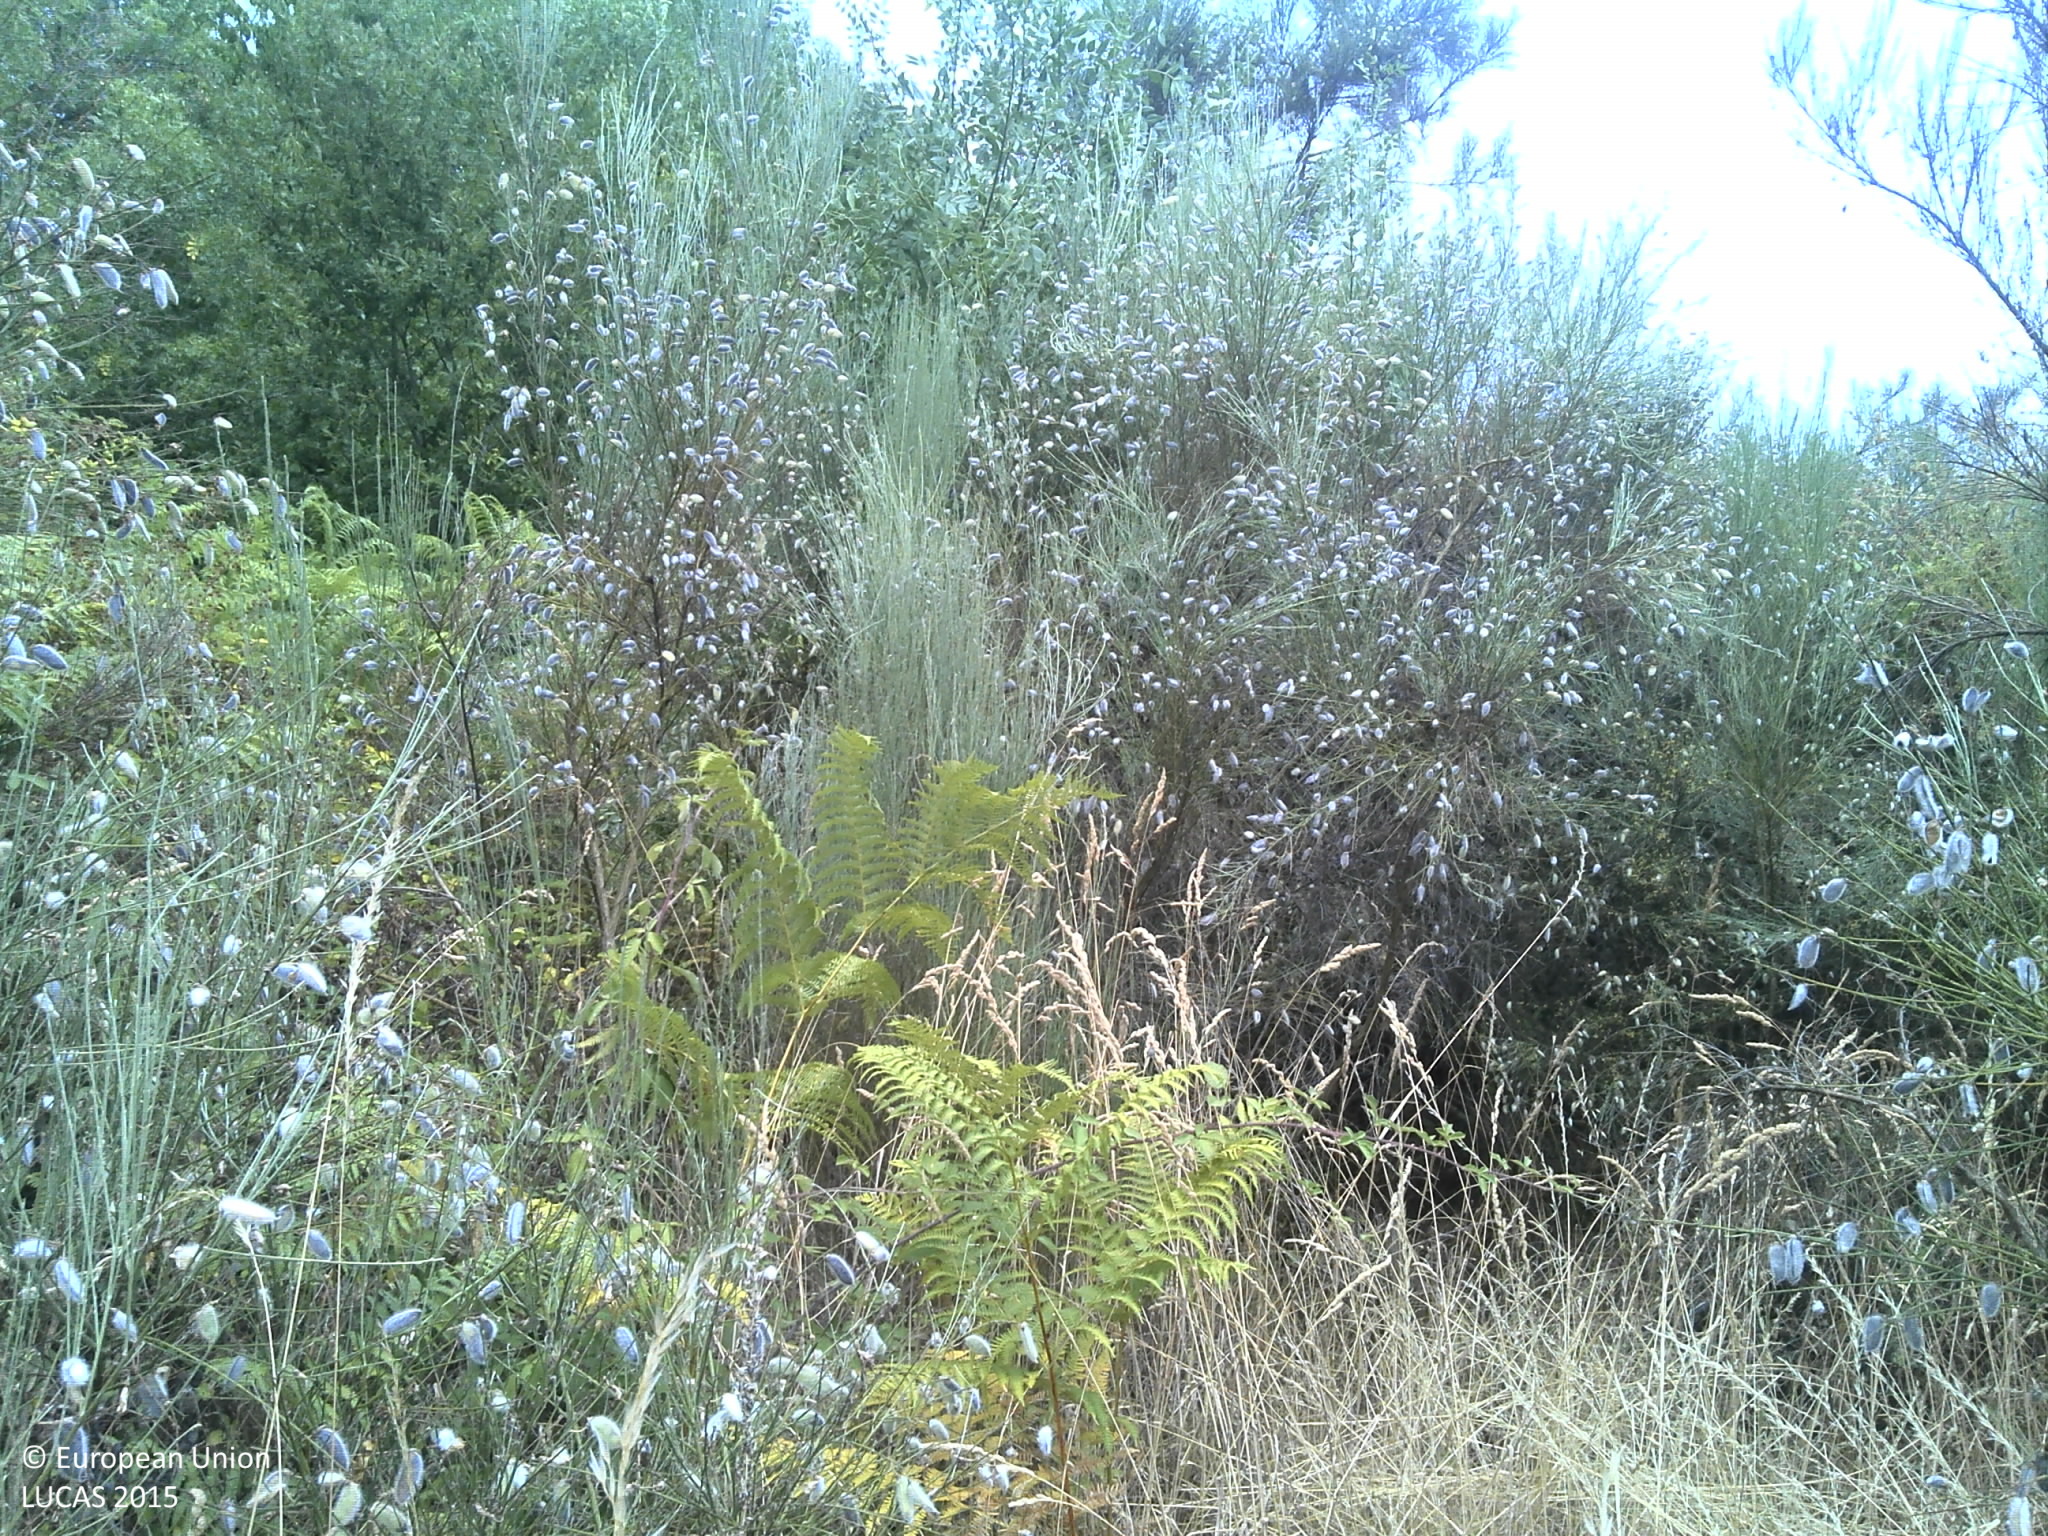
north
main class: Woodland
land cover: Broadleaved woodland
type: mesophytic deciduous forest
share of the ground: 25 - 50 %
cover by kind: shrubs 60 %, broadleaved forest trees 35 %, unconsolidated bare surface 5 %
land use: Semi-natural and natural areas not in use
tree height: > 5 m
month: July
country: PT
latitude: 40.9756
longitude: -7.3591
